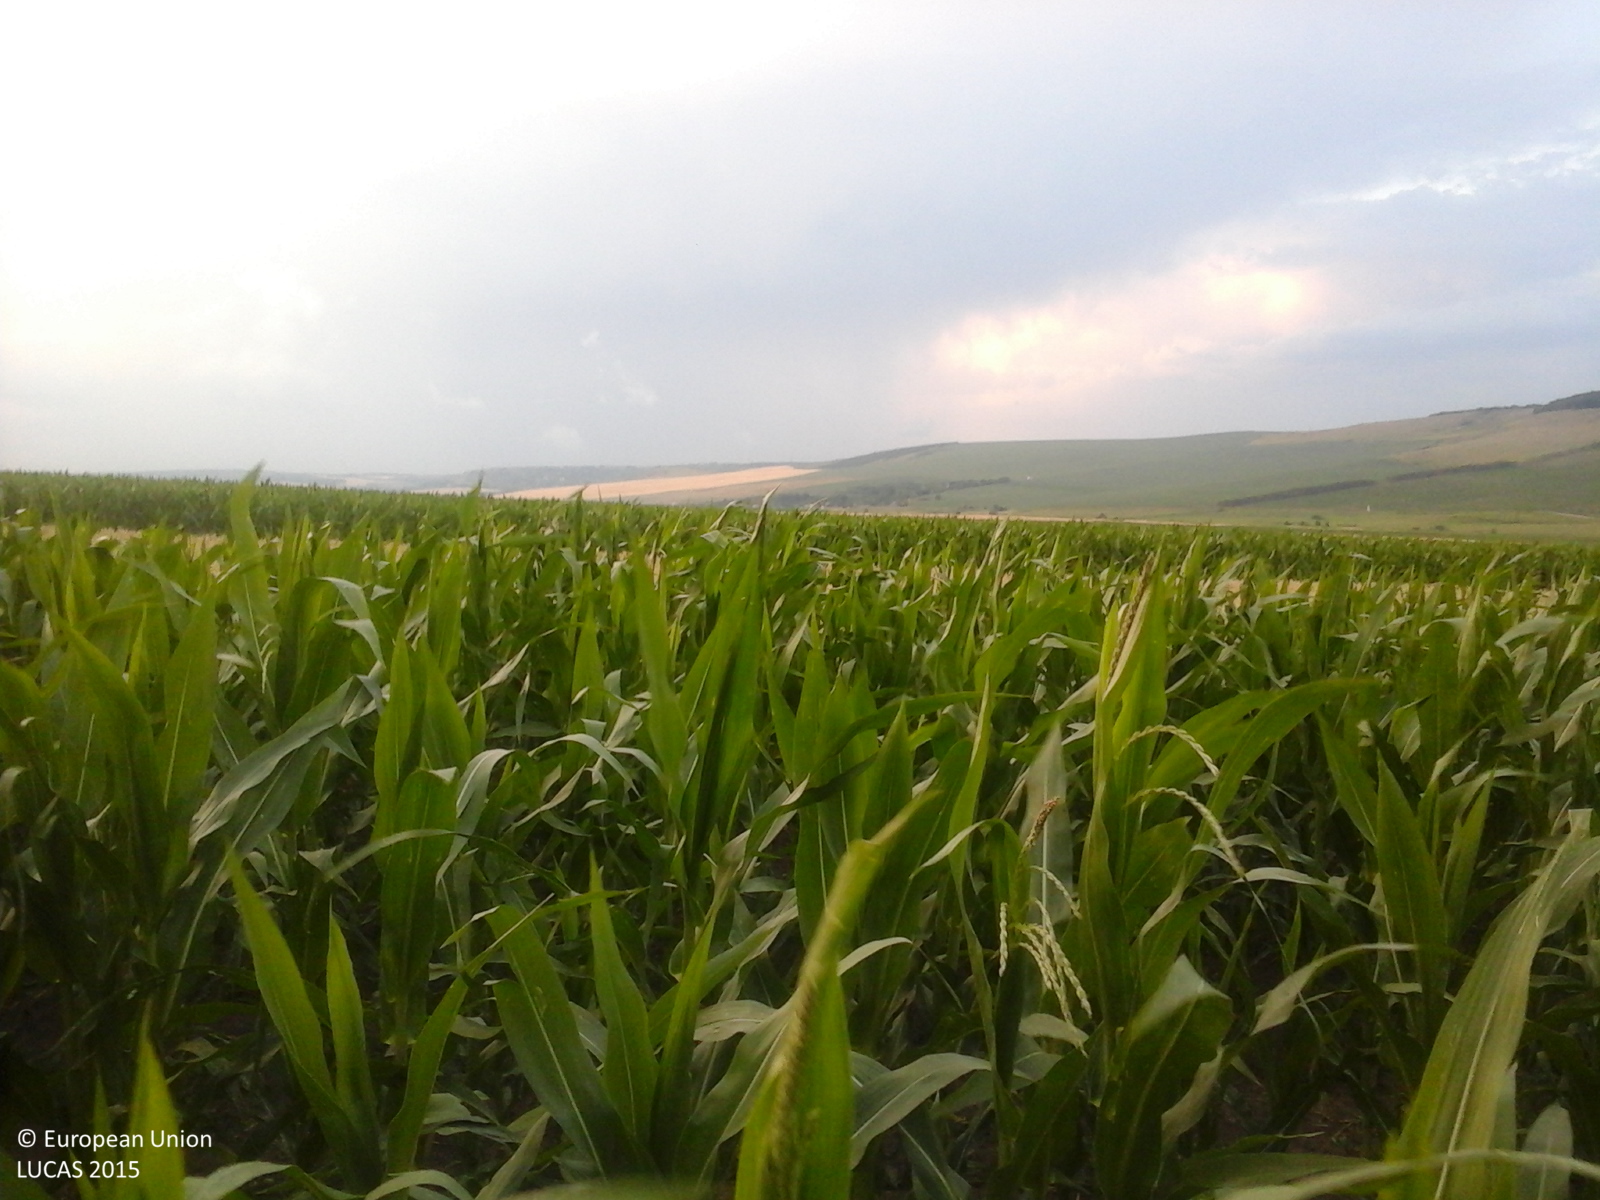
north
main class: Cropland
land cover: Maize
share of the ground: > 75 %
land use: Agriculture (excluding fallow land and kitchen gardens)
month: June
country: RO
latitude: 46.8560
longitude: 27.4378
